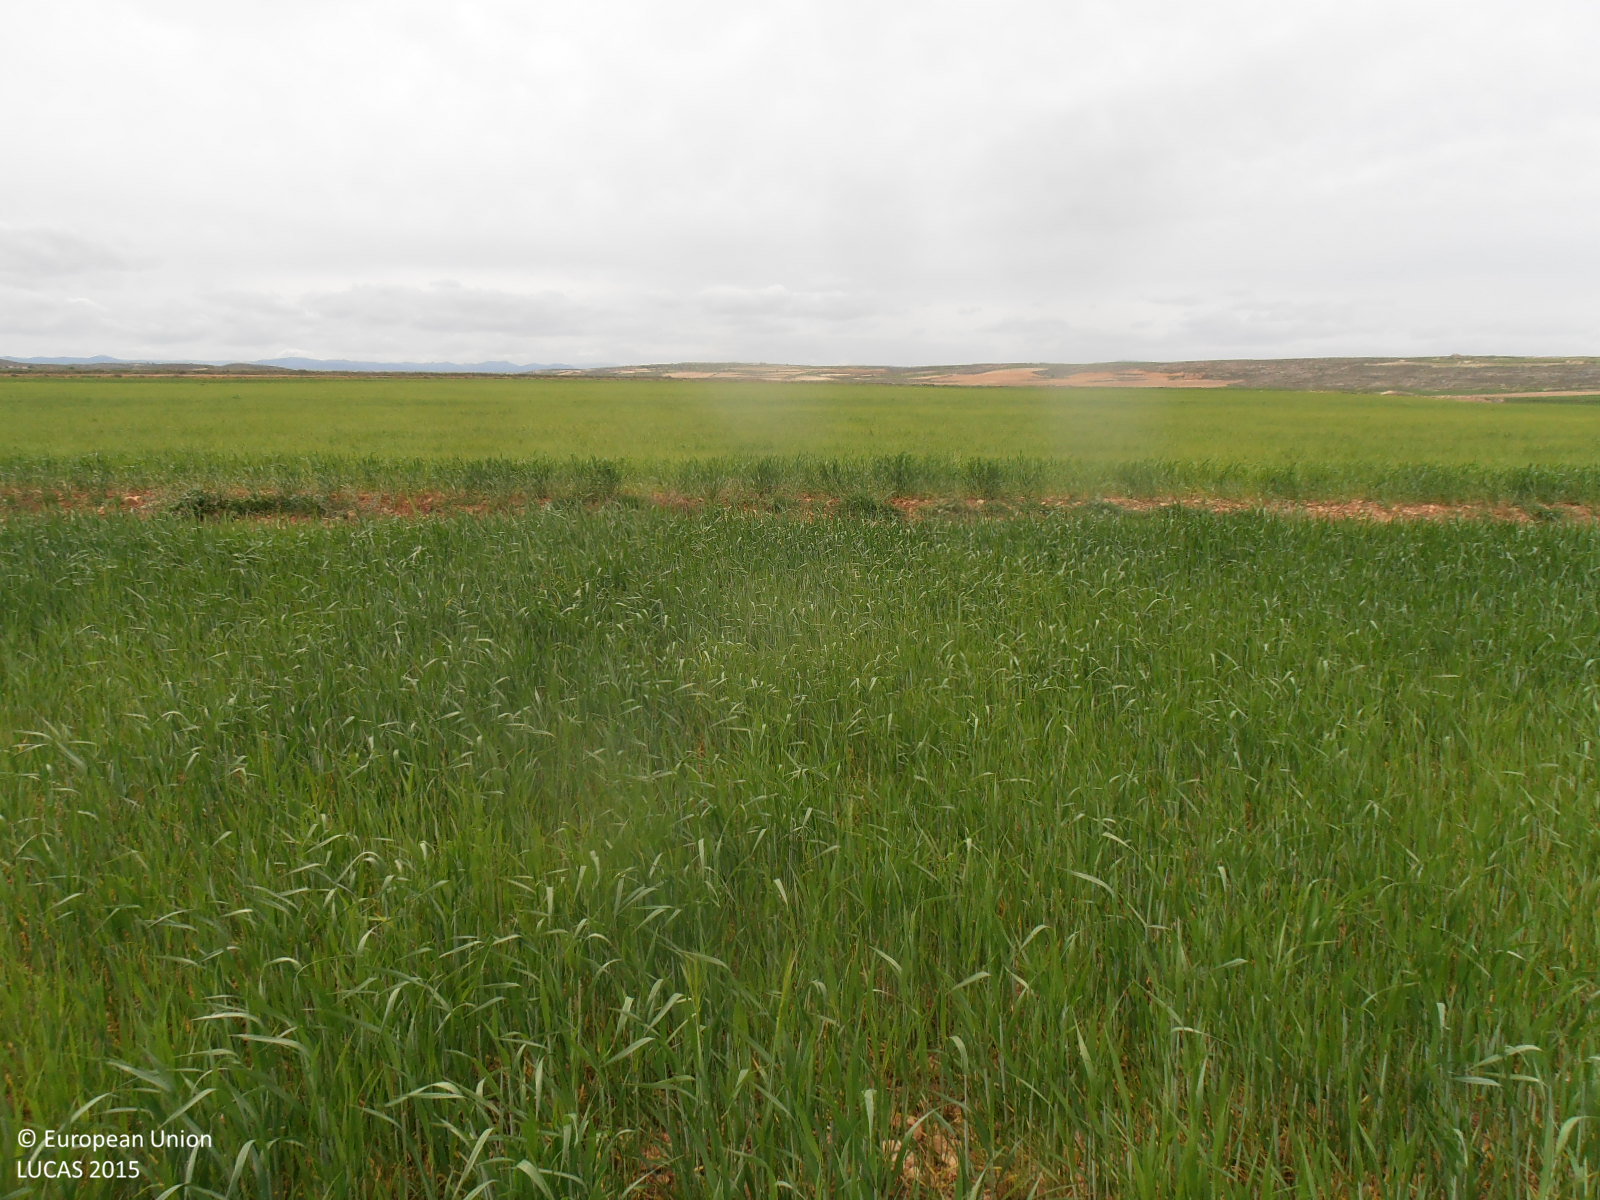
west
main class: Cropland
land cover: Durum wheat
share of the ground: > 75 %
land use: Agriculture (excluding fallow land and kitchen gardens)
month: April
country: ES
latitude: 41.1562
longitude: -0.8732
